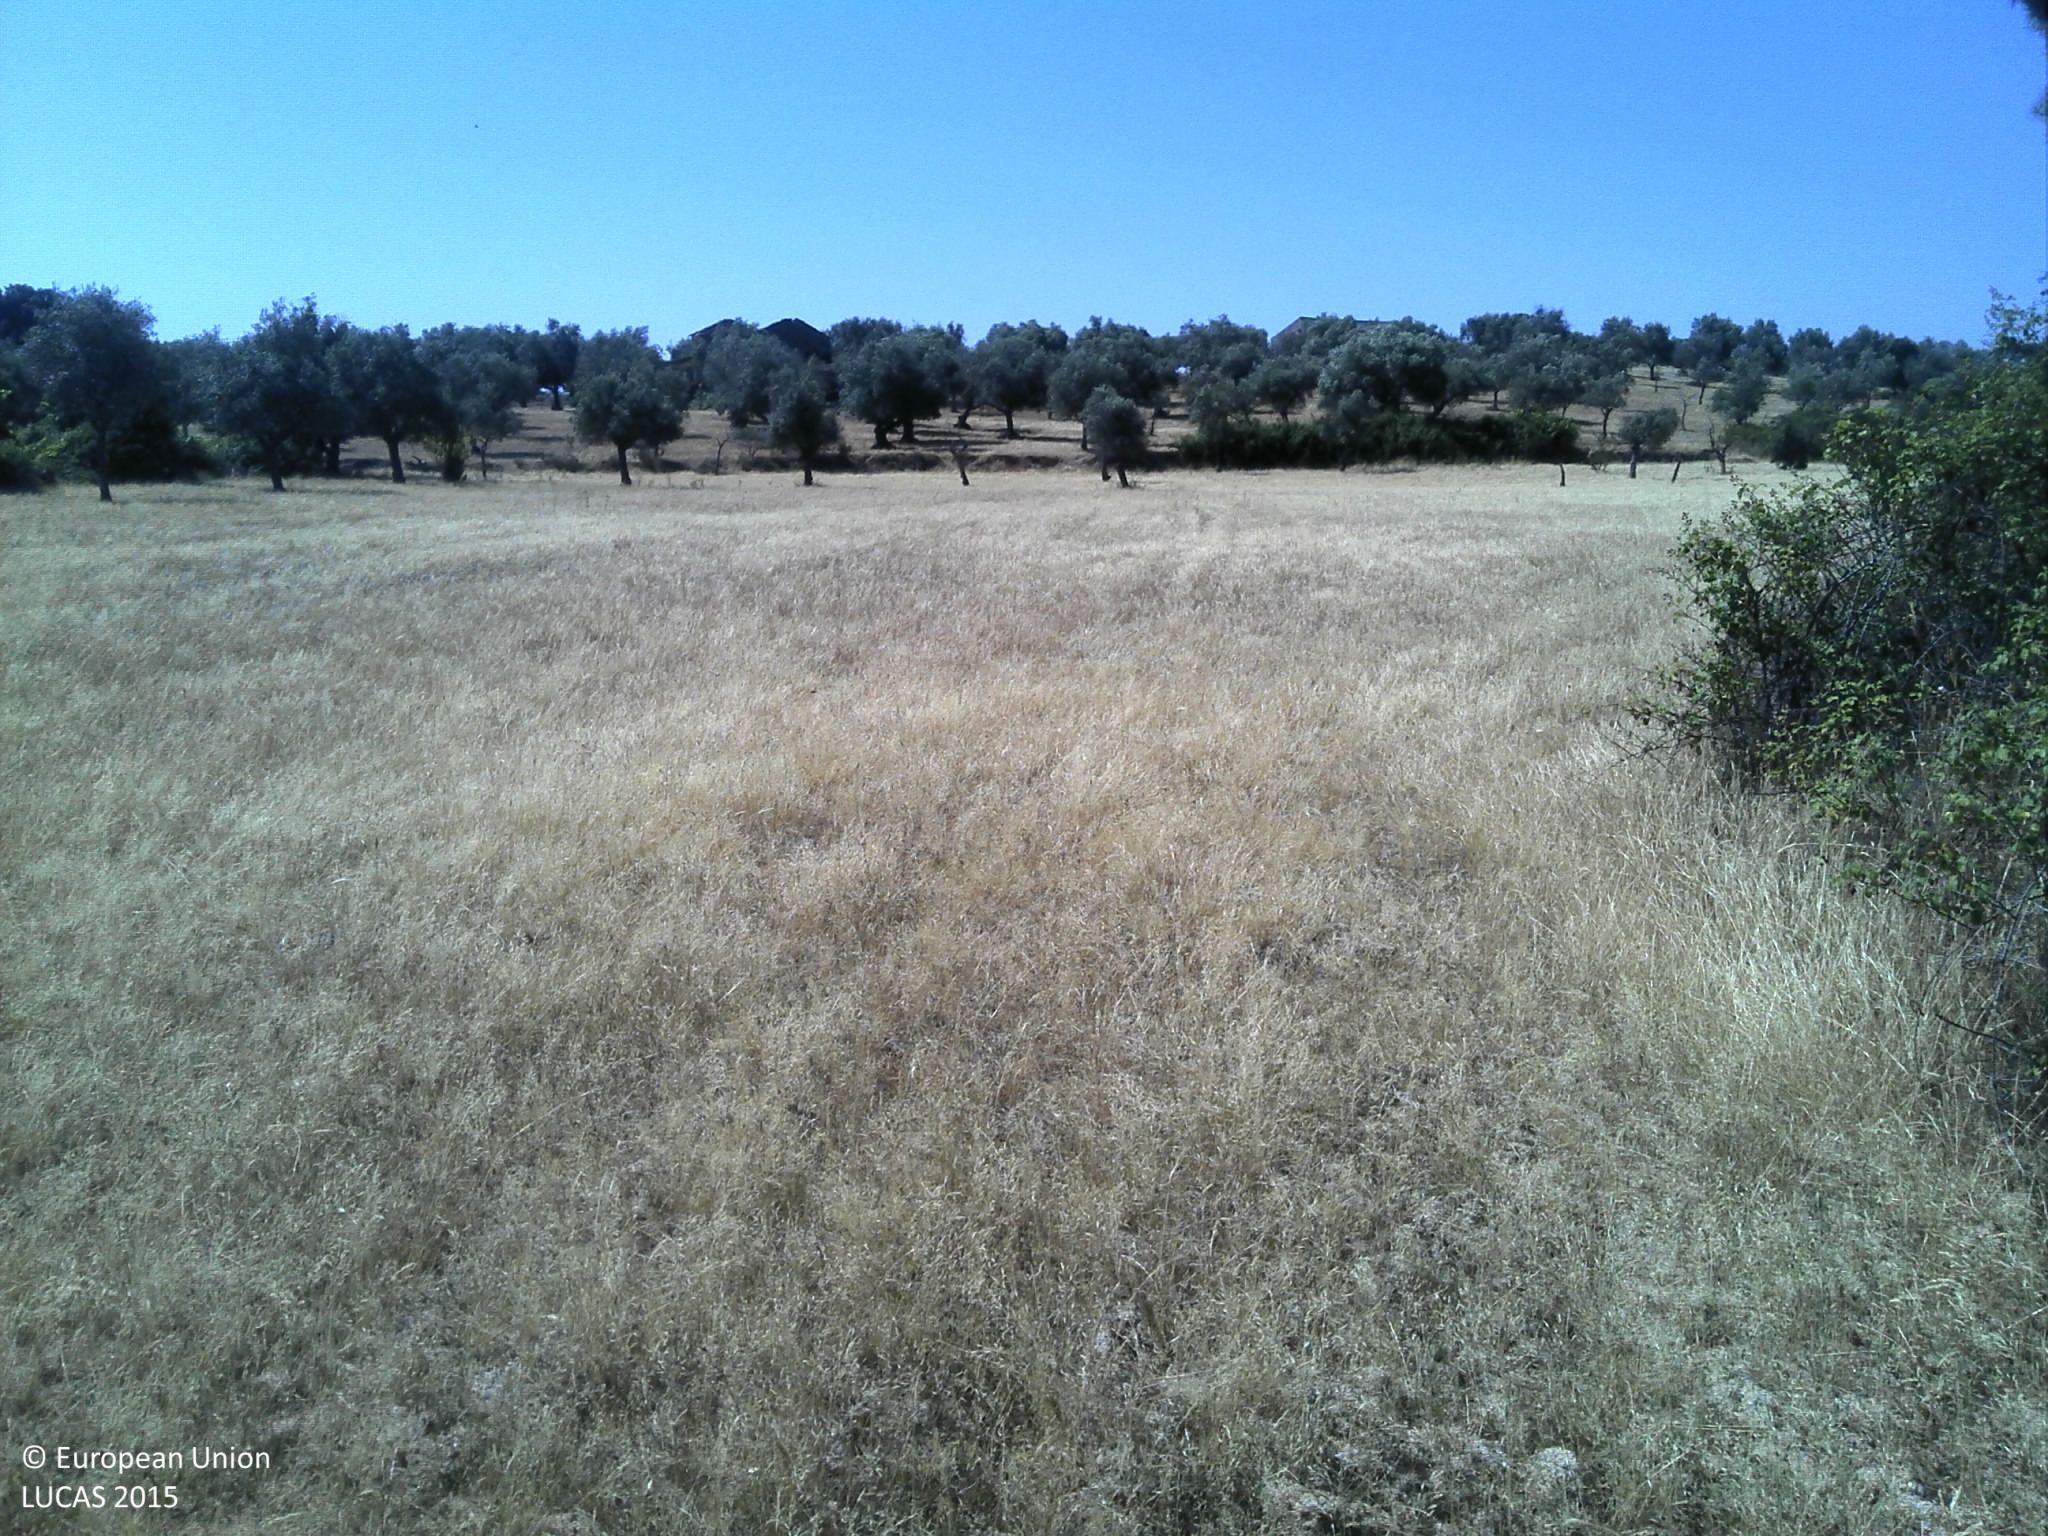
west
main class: Grassland
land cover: Spontaneously vegetated surfaces
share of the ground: 50 - 75 %
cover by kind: herbaceous plants 60 %, unconsolidated bare surface 40 %
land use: Fallow land
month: June
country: PT
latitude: 40.0346
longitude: -7.3619
